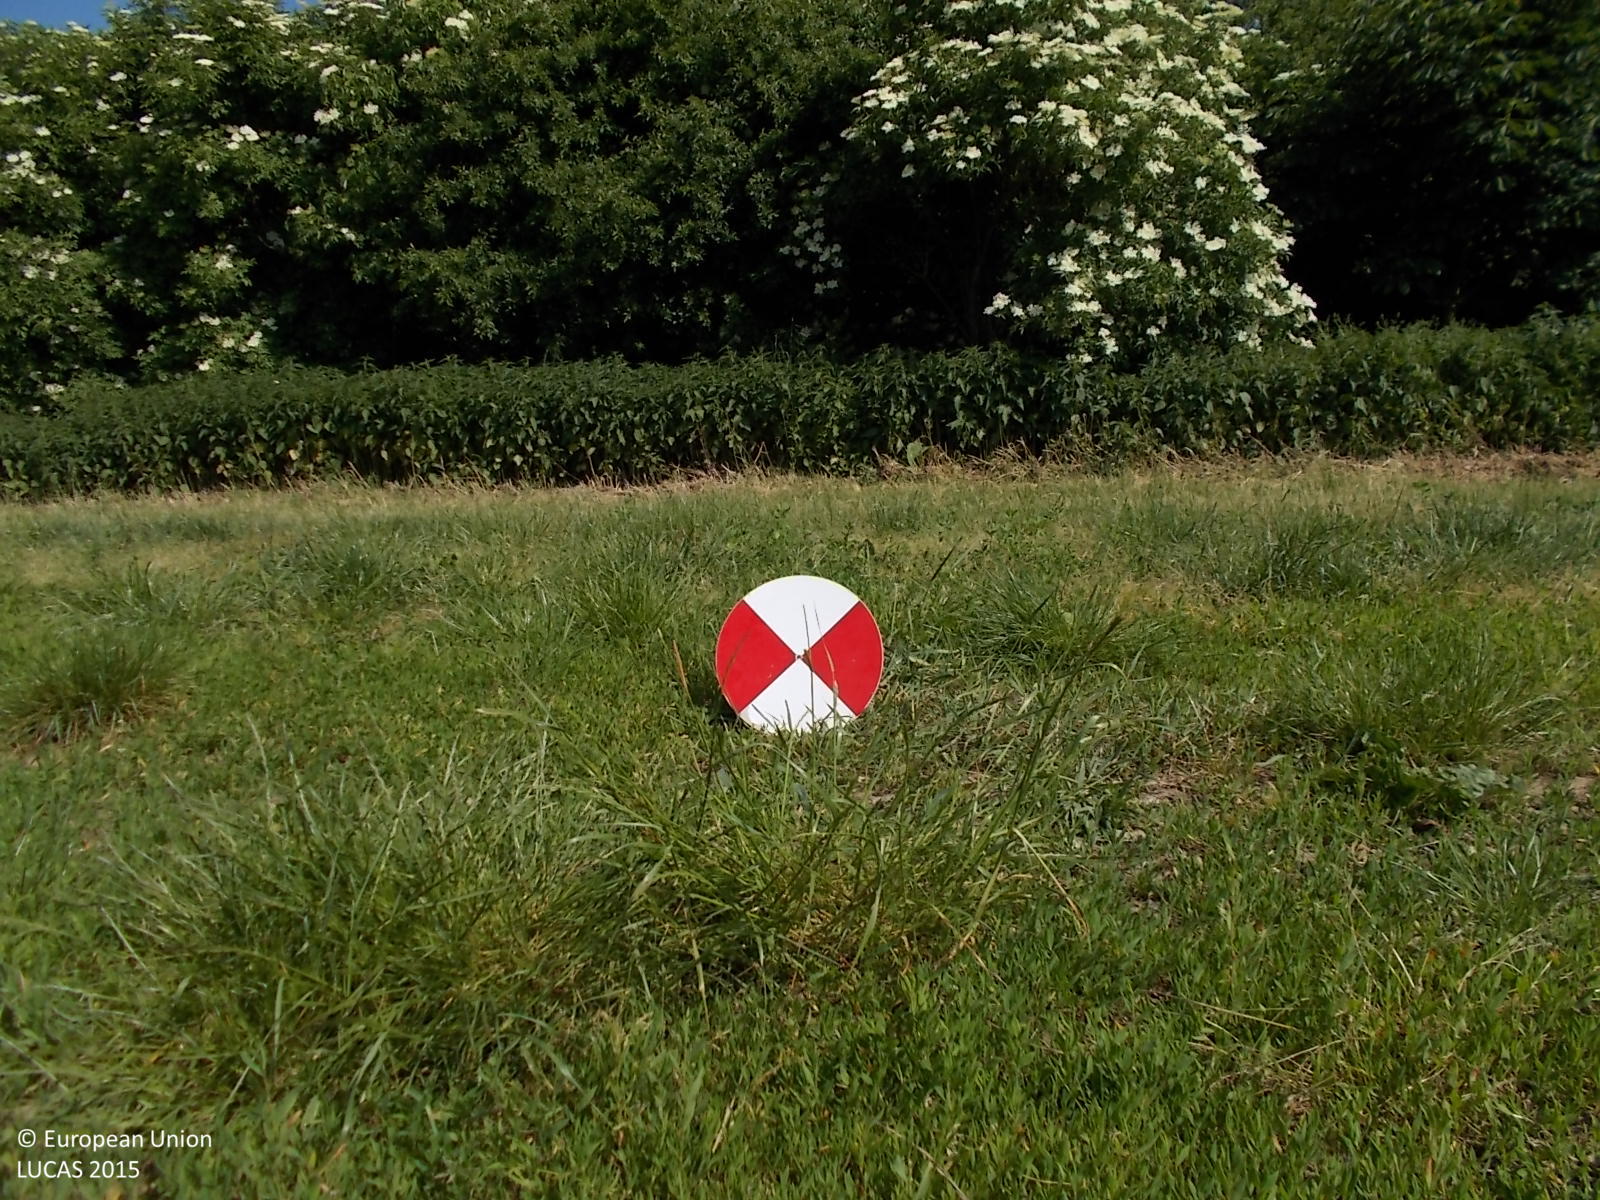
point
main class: Grassland
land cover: Grassland without tree/shrub cover
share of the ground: > 75 %
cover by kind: herbaceous plants 90 %, unconsolidated bare surface 10 %
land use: Agriculture (excluding fallow land and kitchen gardens)
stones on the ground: 10 - 25 %
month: June
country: CZ
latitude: 49.3311
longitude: 17.0964
